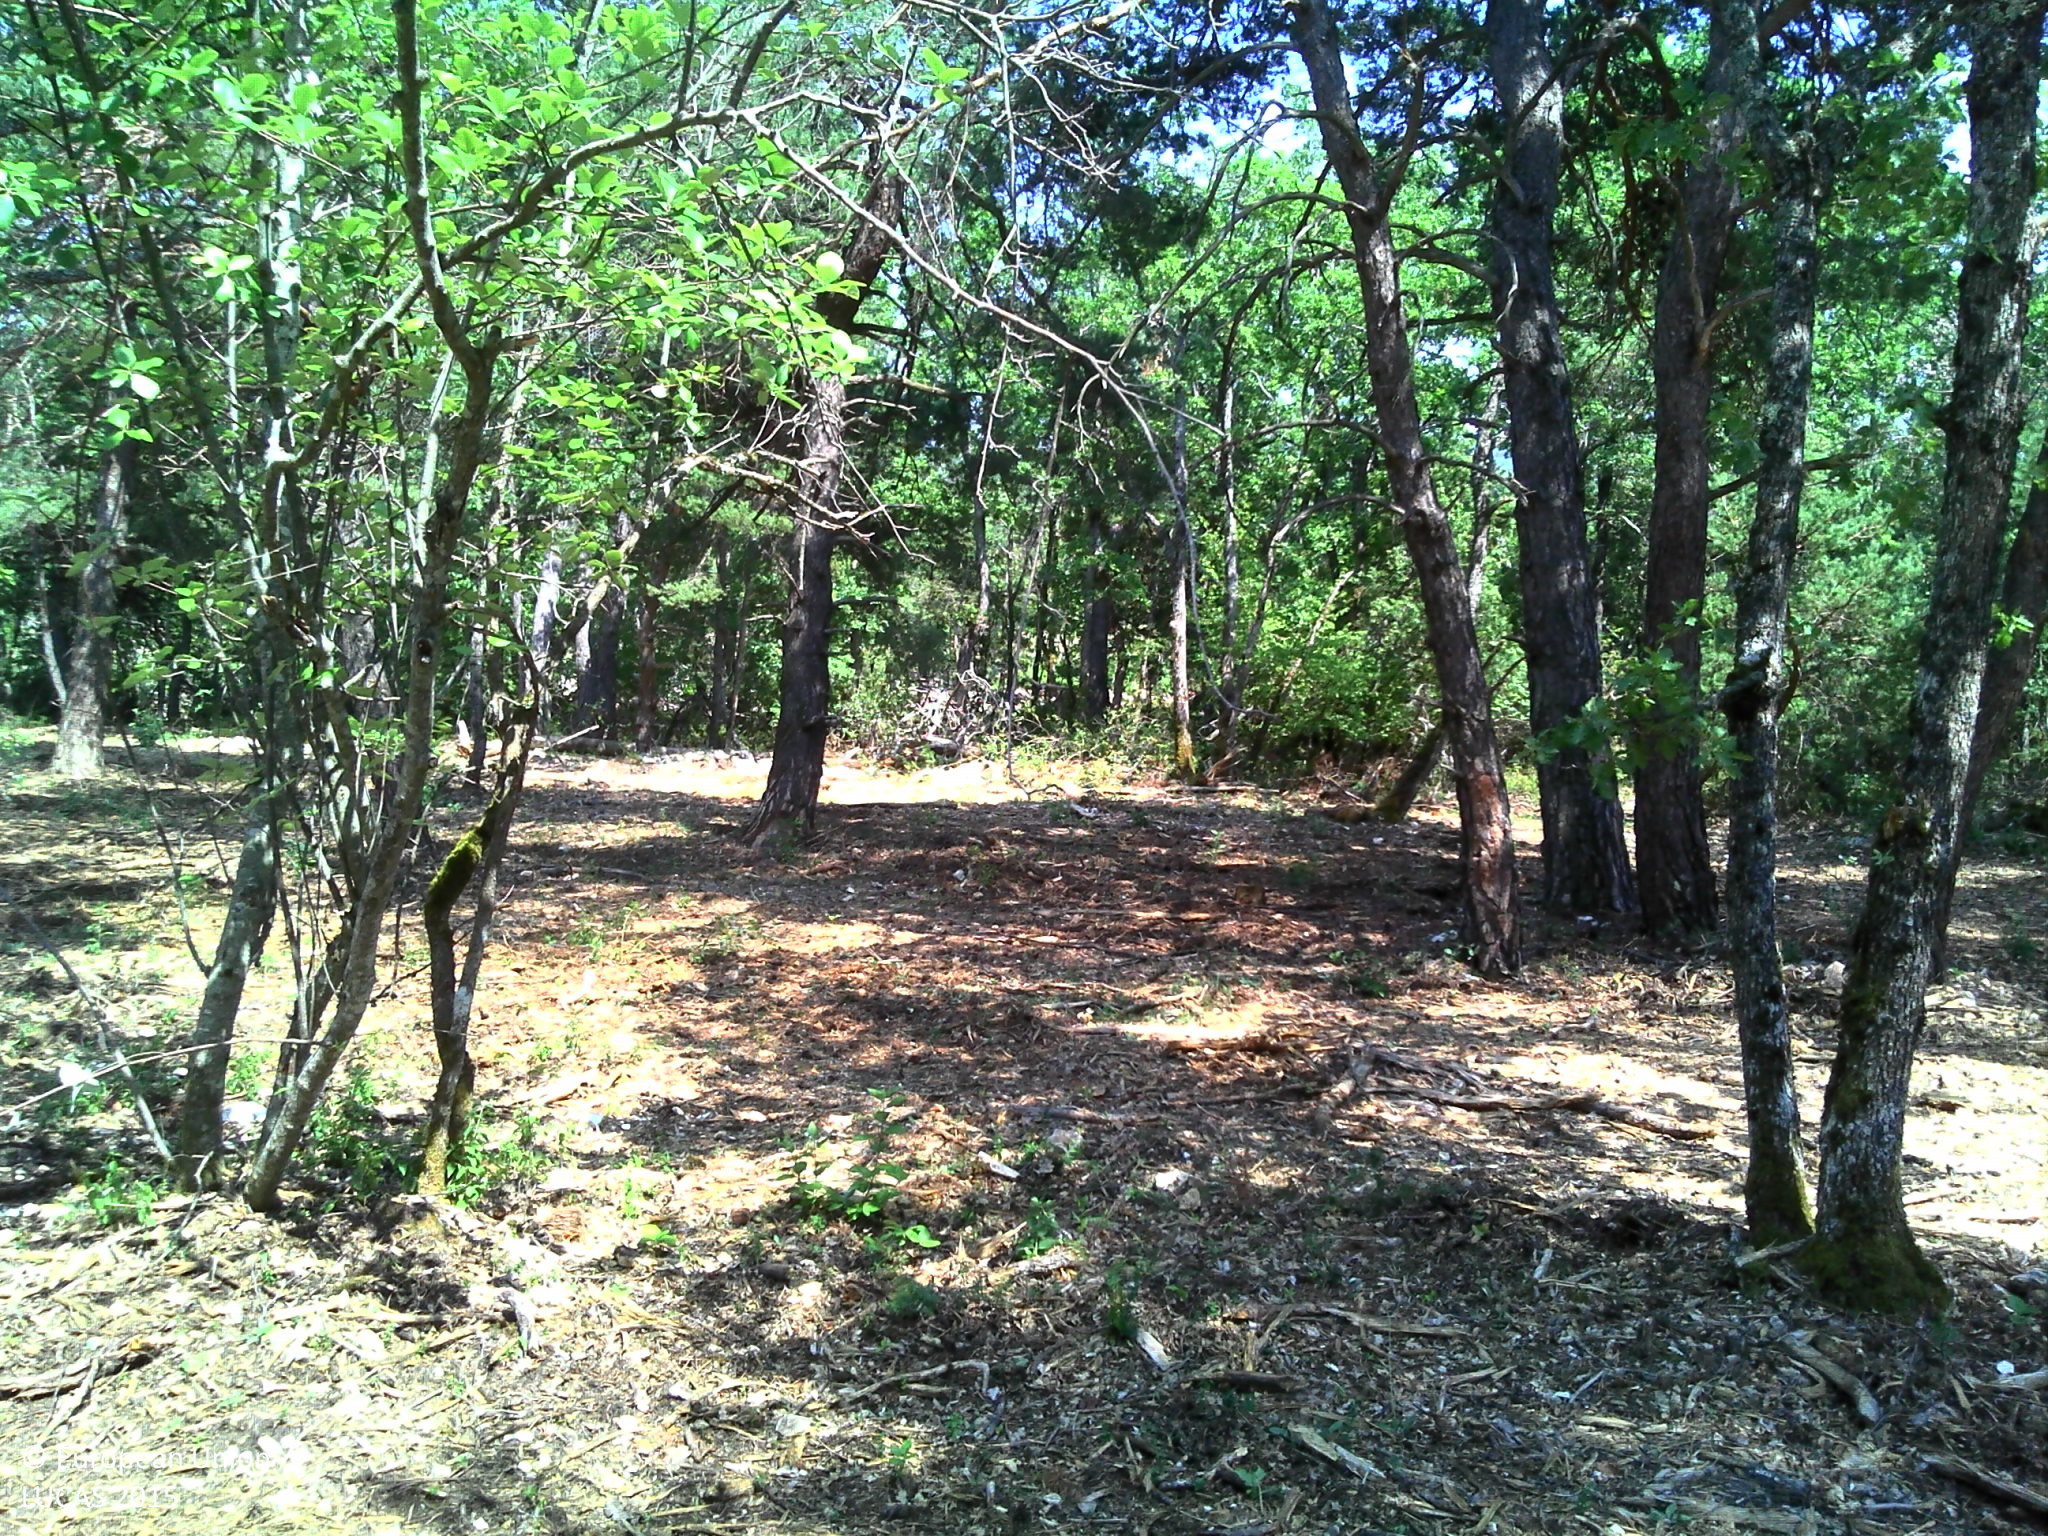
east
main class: Woodland
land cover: Pine dominated mixed woodland
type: mesophytic deciduous forest
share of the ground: > 75 %
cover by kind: coniferous forest trees 35 %, broadleaved forest trees 20 %, shrubs 20 %, unconsolidated bare surface 20 %, herbaceous plants 5 %
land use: Forestry
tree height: > 5 m
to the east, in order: Pine dominated mixed woodland; Dry stone walls; Pine dominated mixed woodland; Grassland without tree/shrub cover; Tracks; Grassland with sparse tree/shrub cover; Tracks; Grassland without tree/shrub cover; Pine dominated mixed woodland
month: July
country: FR
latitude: 44.0118
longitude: 5.3558
